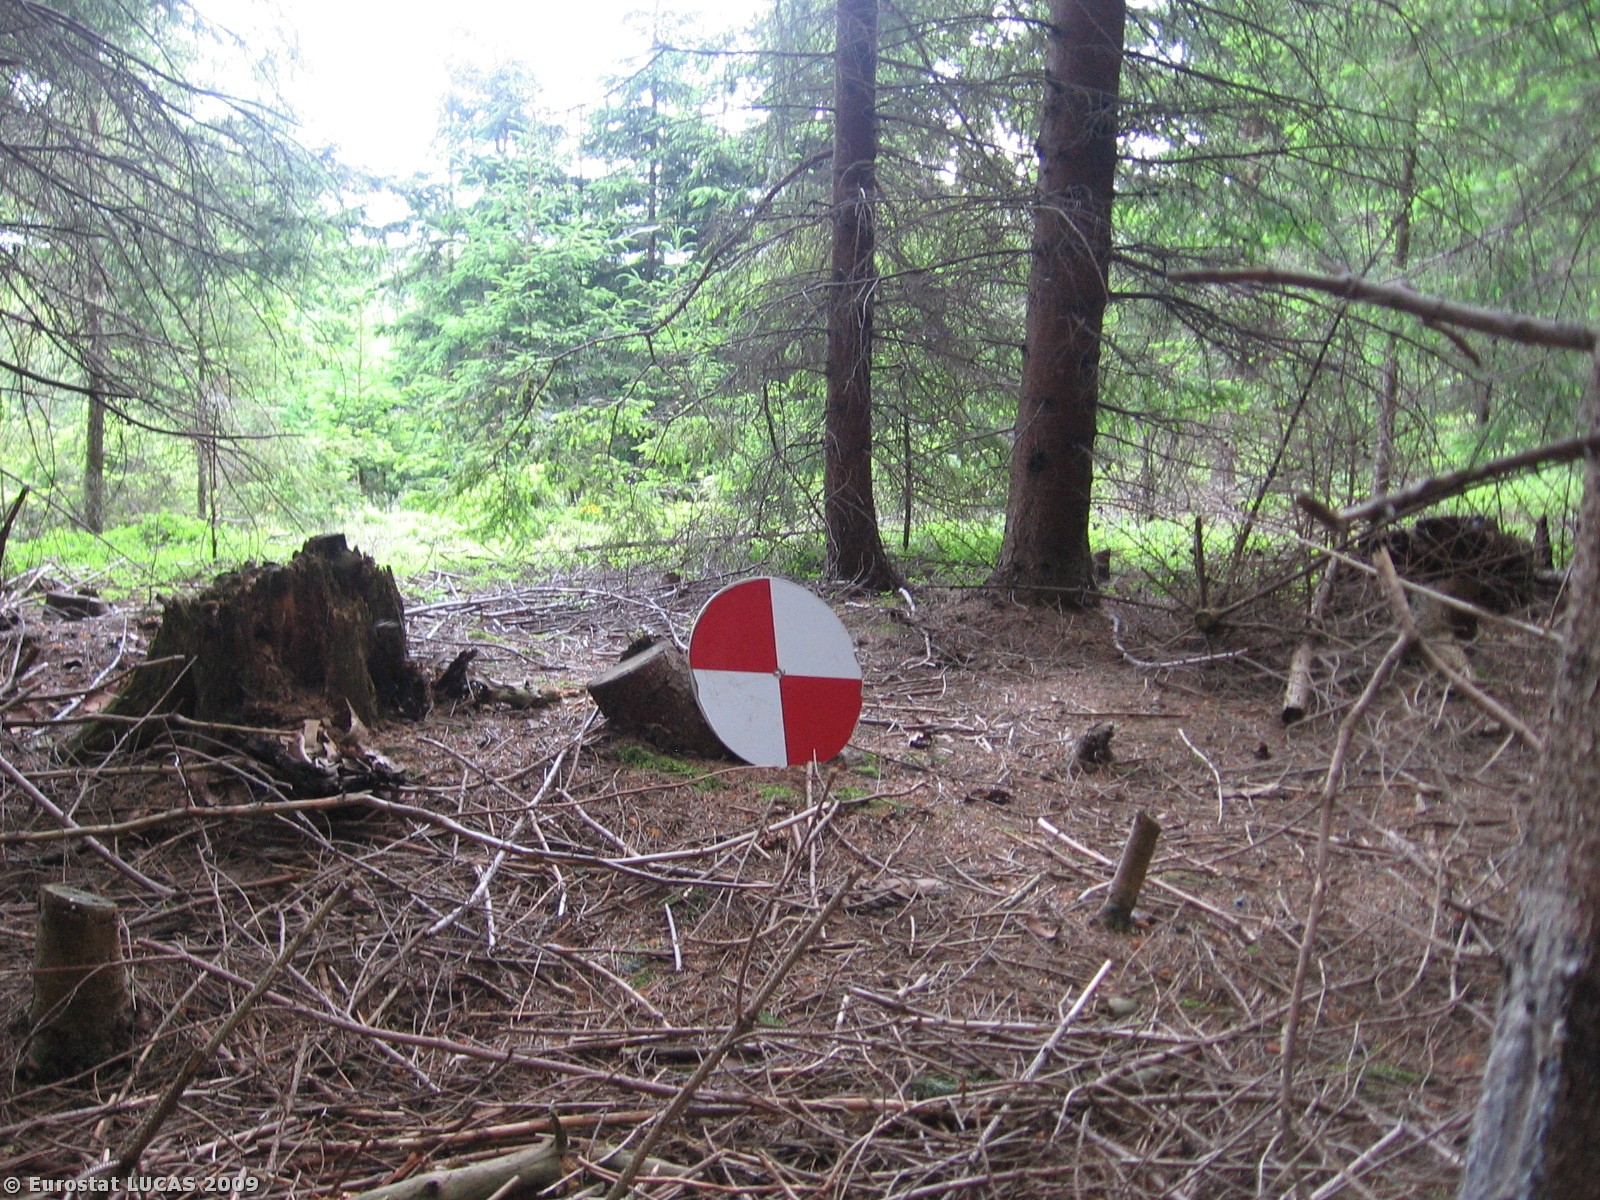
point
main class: Woodland
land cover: Coniferous woodland
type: hemiboreal forest and nemoral coniferous forest and mixed broadleaved-coniferous forest
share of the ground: > 75 %
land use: Forestry
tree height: > 5 m
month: June
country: CZ
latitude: 49.0571
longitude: 13.8456
